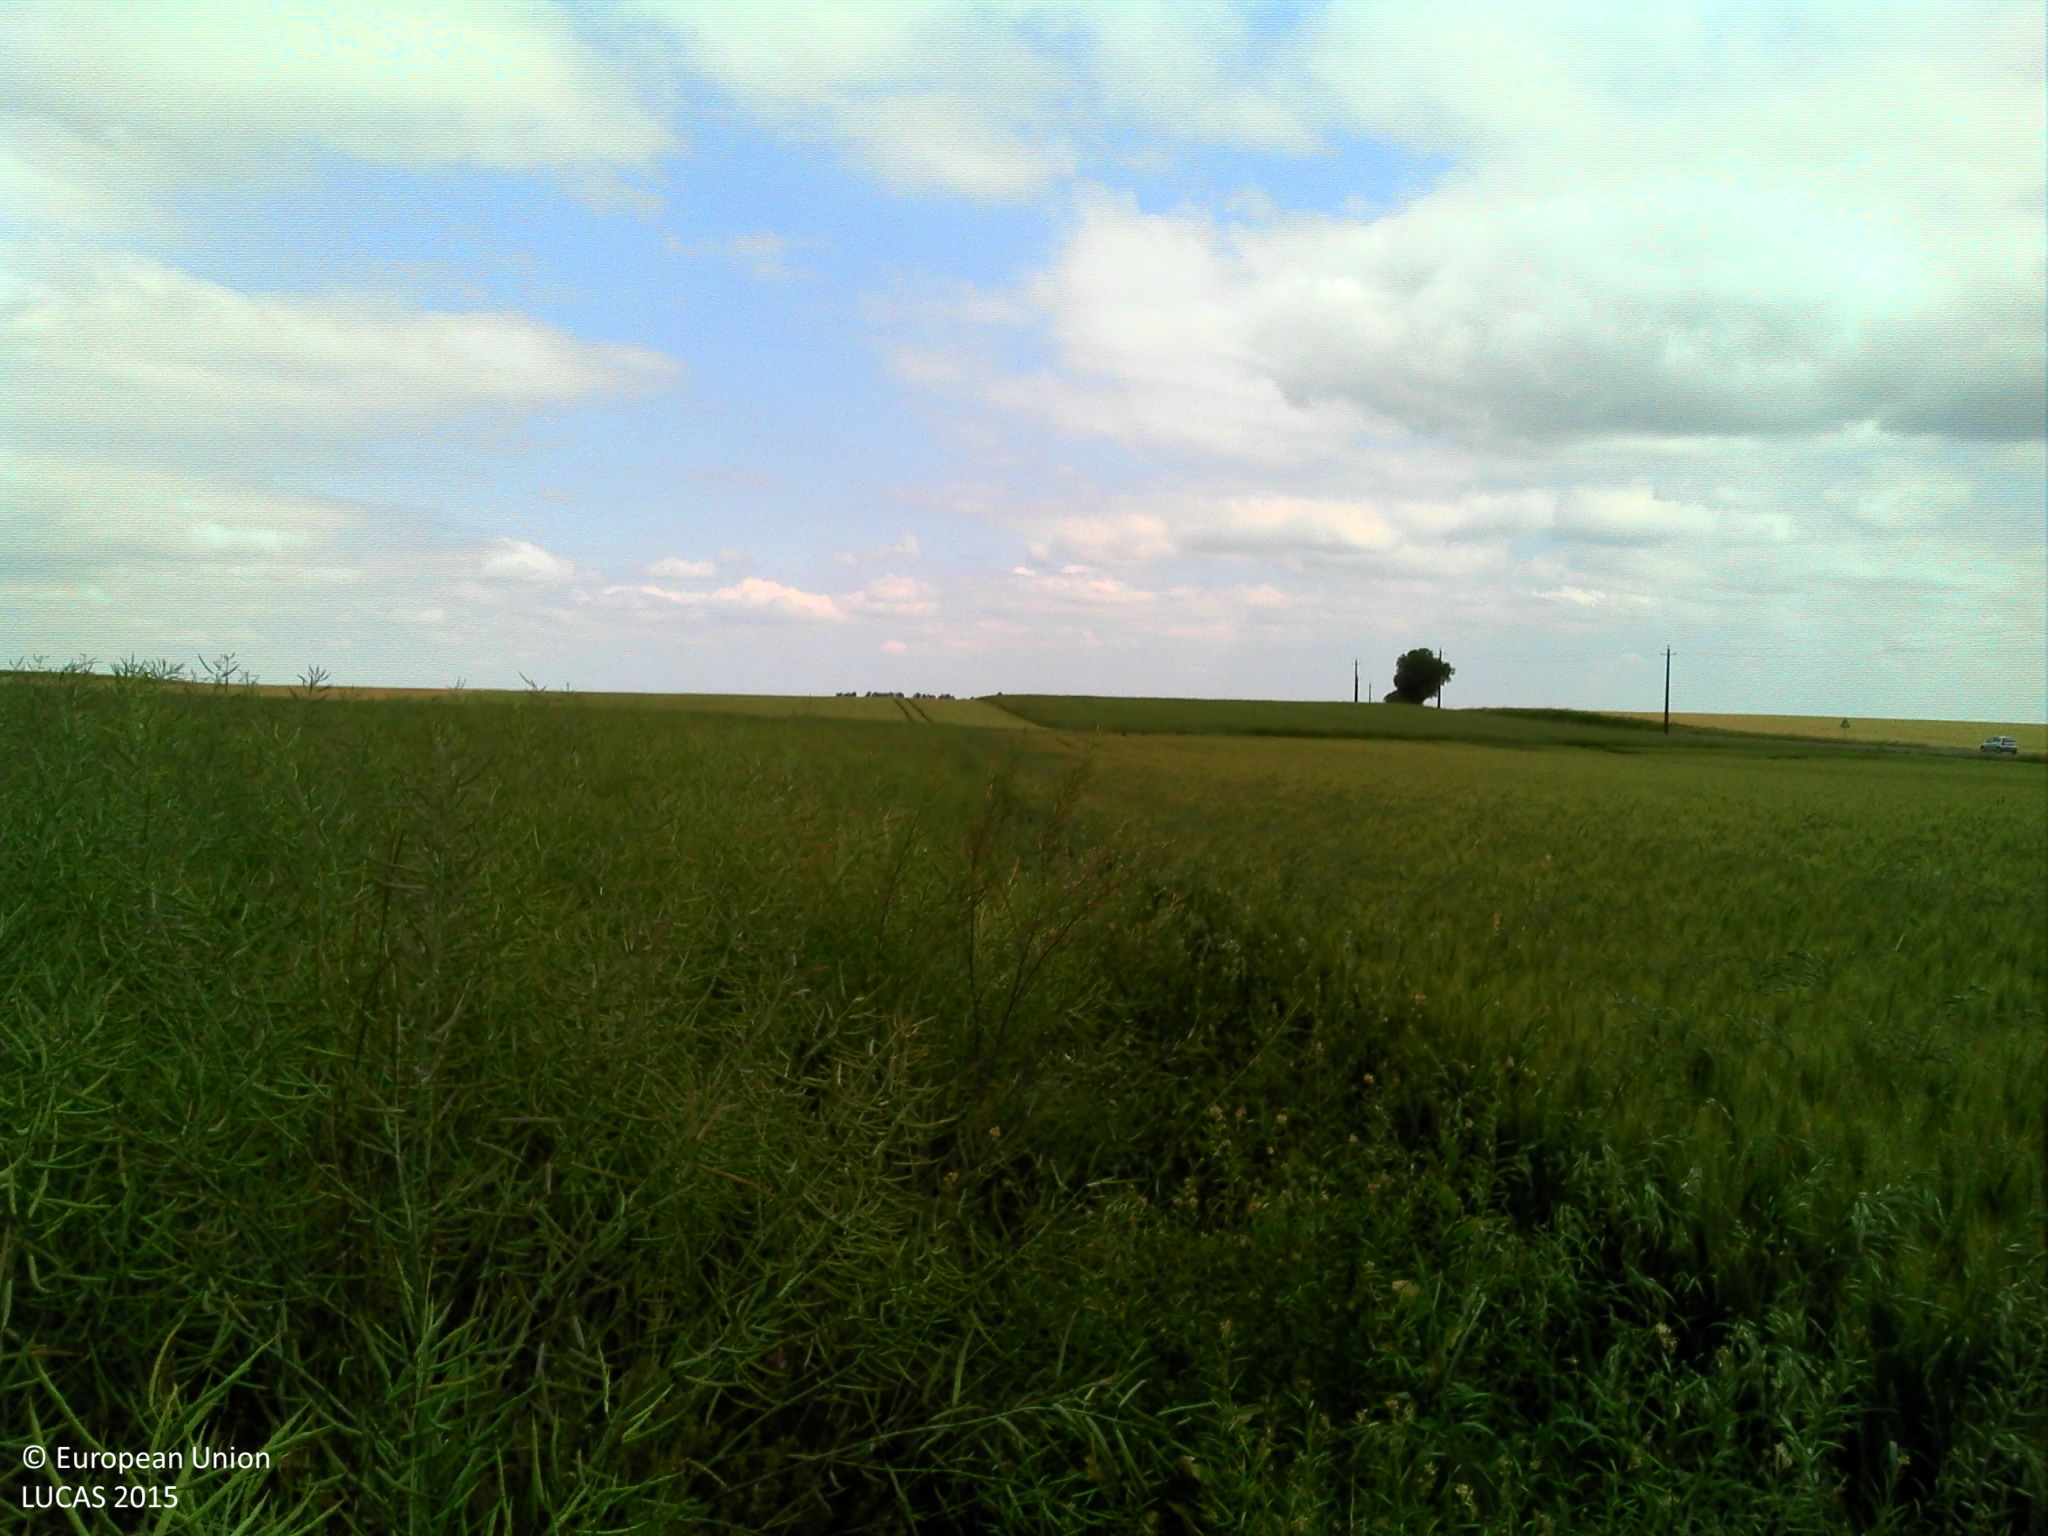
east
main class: Cropland
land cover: Rape and turnip rape
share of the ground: > 75 %
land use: Agriculture (excluding fallow land and kitchen gardens)
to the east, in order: Rape and turnip rape; Grass margins; Paved roads, cycling and walking lanes; Grass margins; Rape and turnip rape
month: June
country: FR
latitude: 47.3448
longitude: 5.2224
